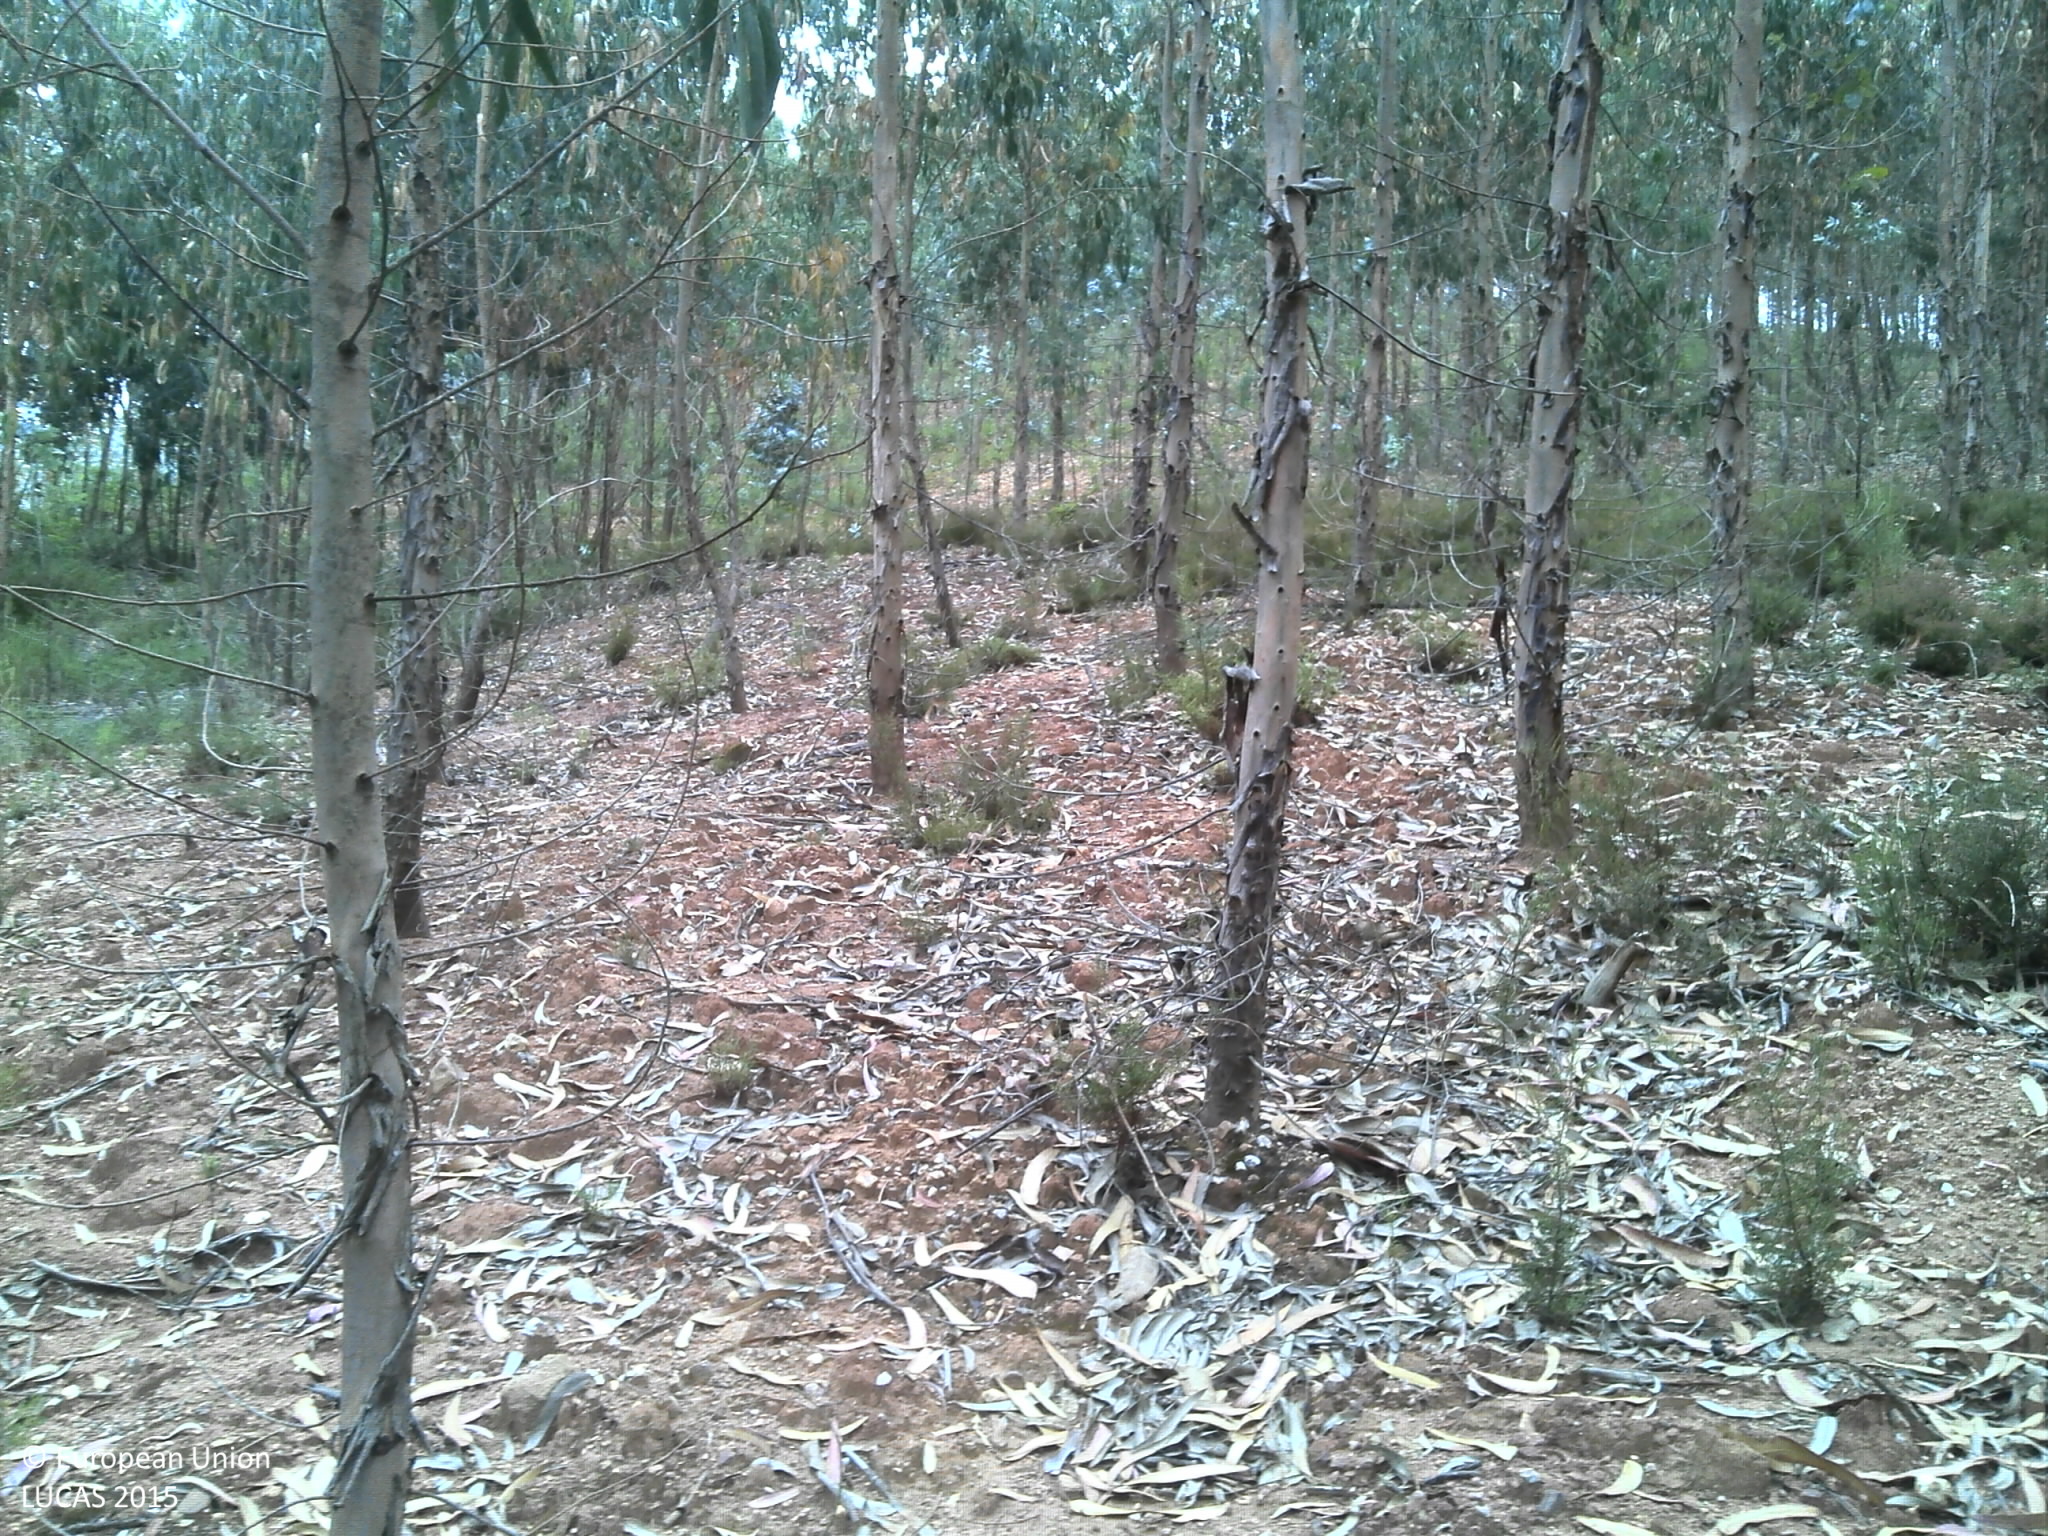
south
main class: Woodland
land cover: Broadleaved woodland
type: exotic forest
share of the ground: 50 - 75 %
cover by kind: broadleaved forest trees 60 %, unconsolidated bare surface 30 %, shrubs 10 %
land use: Forestry
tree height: > 5 m
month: June
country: PT
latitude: 40.4171
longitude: -8.3886
